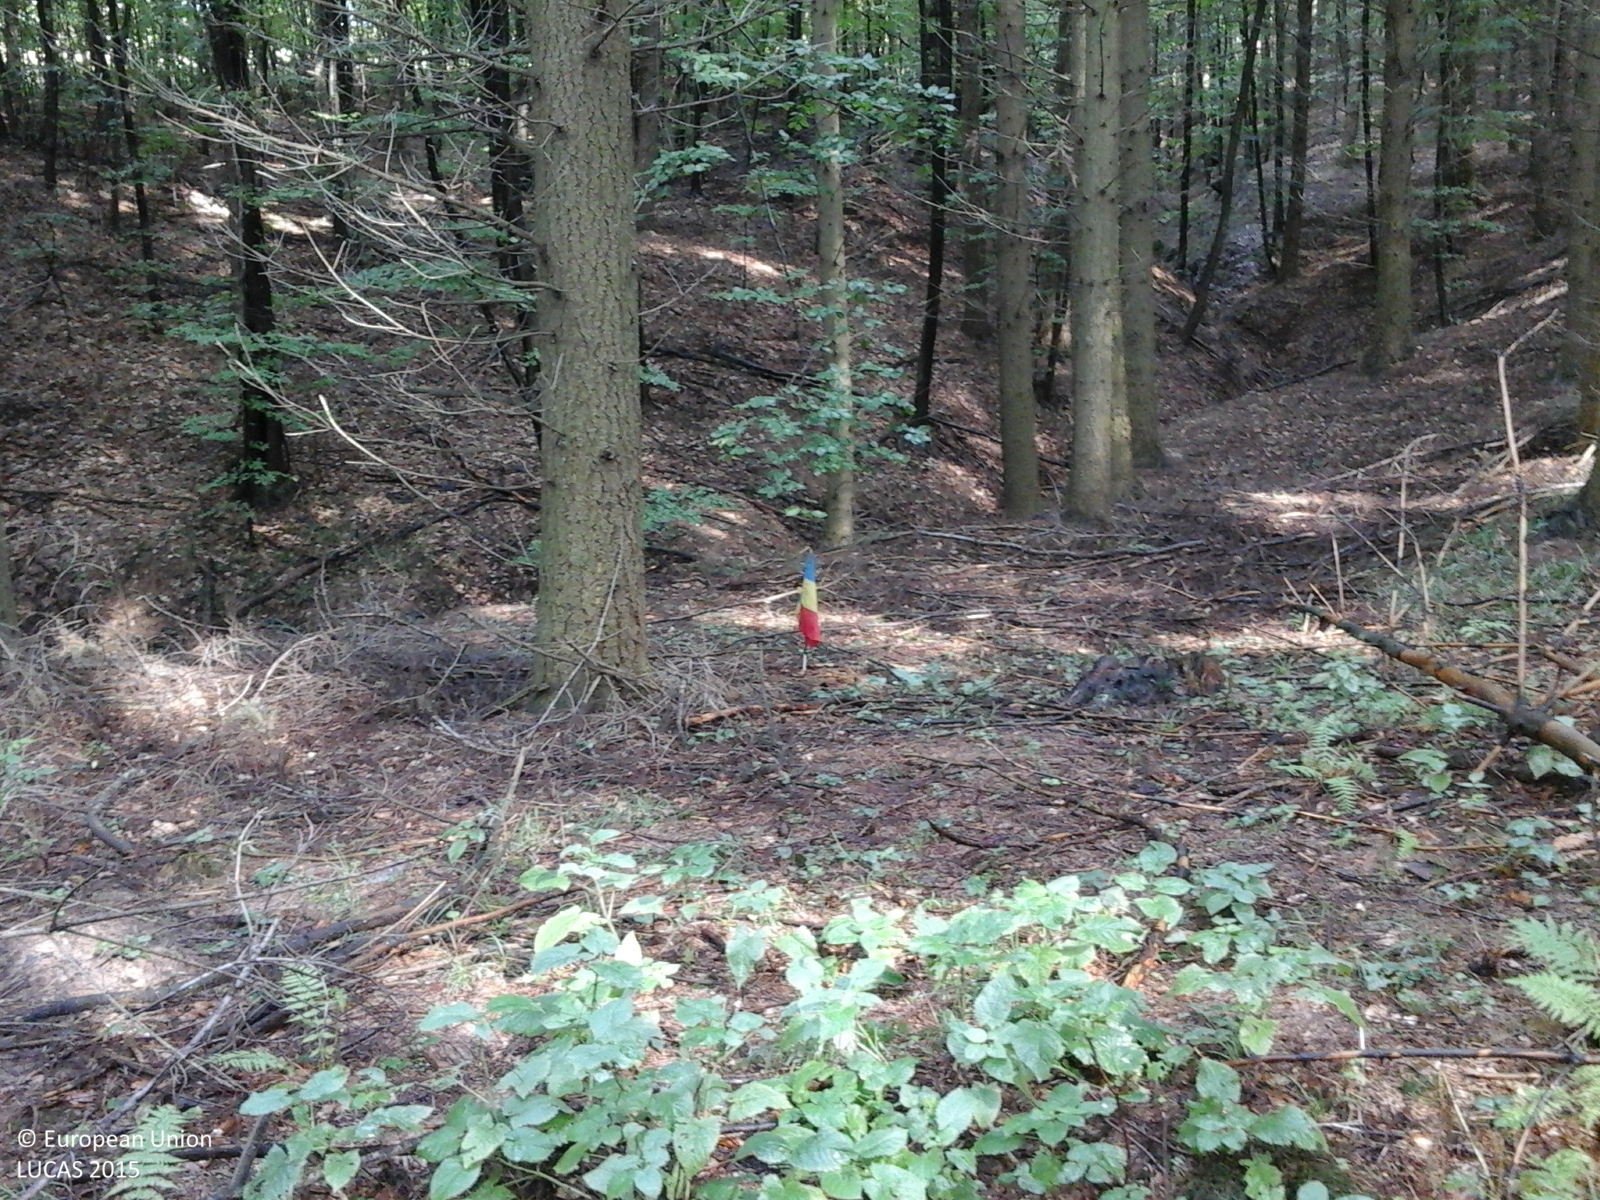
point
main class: Woodland
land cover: Pine dominated mixed woodland
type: alpine coniferous forest
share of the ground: > 75 %
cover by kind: coniferous forest trees 75 %, broadleaved forest trees 25 %
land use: Forestry
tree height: > 5 m
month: September
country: RO
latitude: 46.9443
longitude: 22.6552
